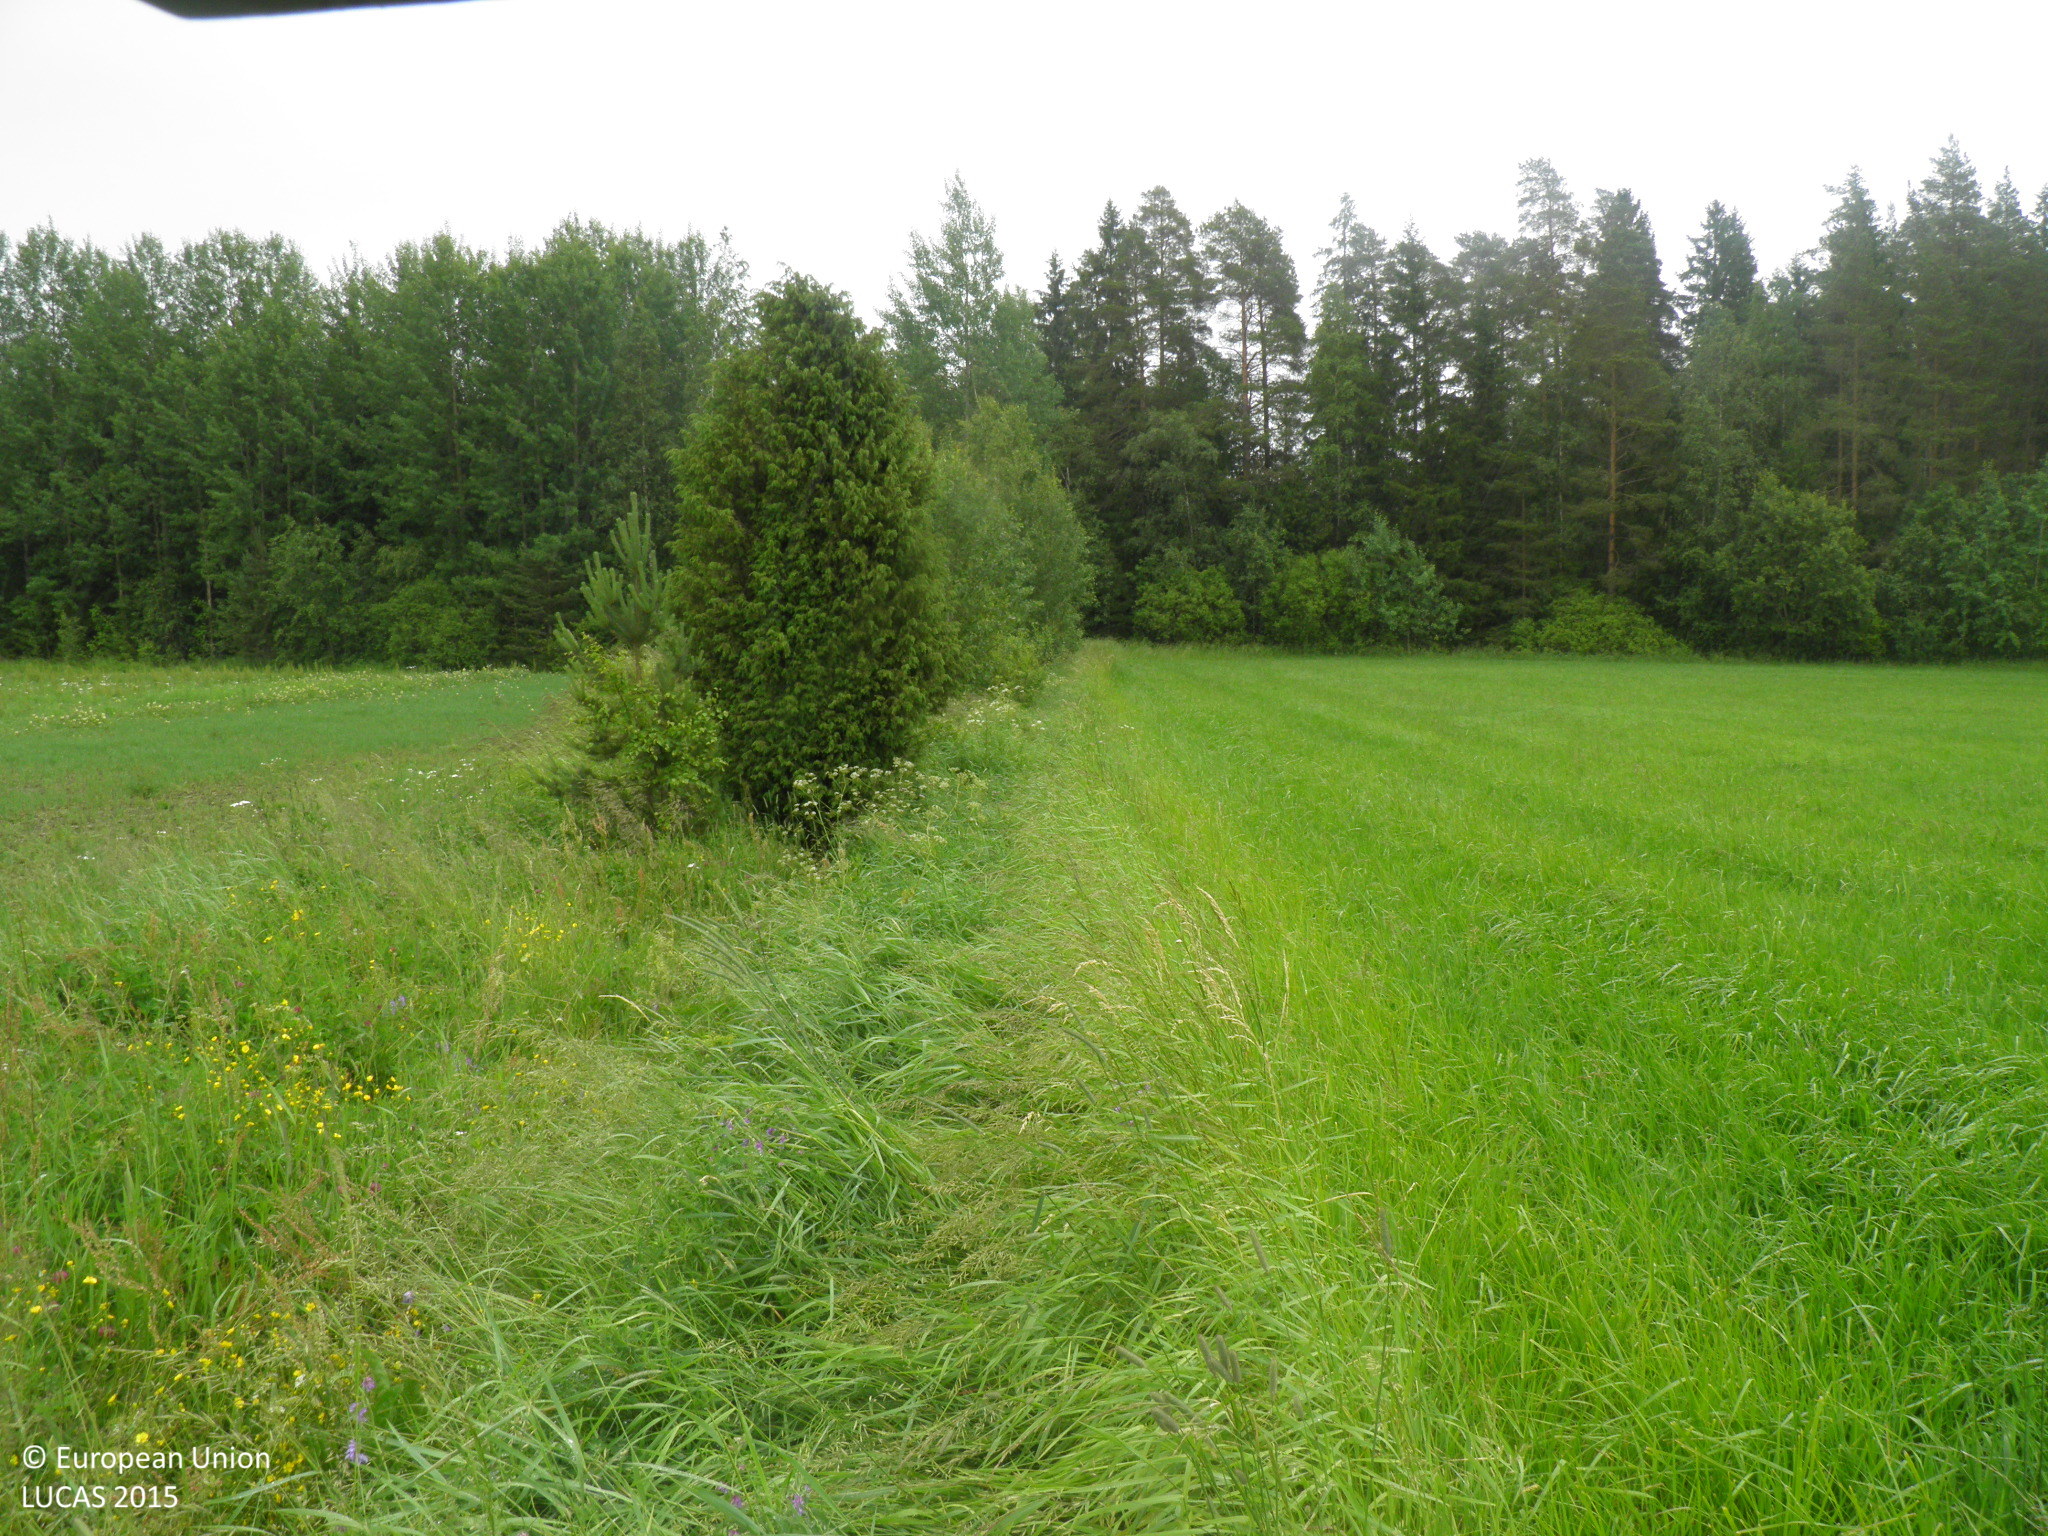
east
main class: Cropland
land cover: Temporary grasslands
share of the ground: > 75 %
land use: Agriculture (excluding fallow land and kitchen gardens)
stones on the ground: < 10 %
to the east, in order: Temporary grasslands; Ditches and canals; Spruce dominated coniferous woodland; Spruce dominated mixed woodland; Broadleaved woodland
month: July
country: FI
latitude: 60.6556
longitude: 22.7874
